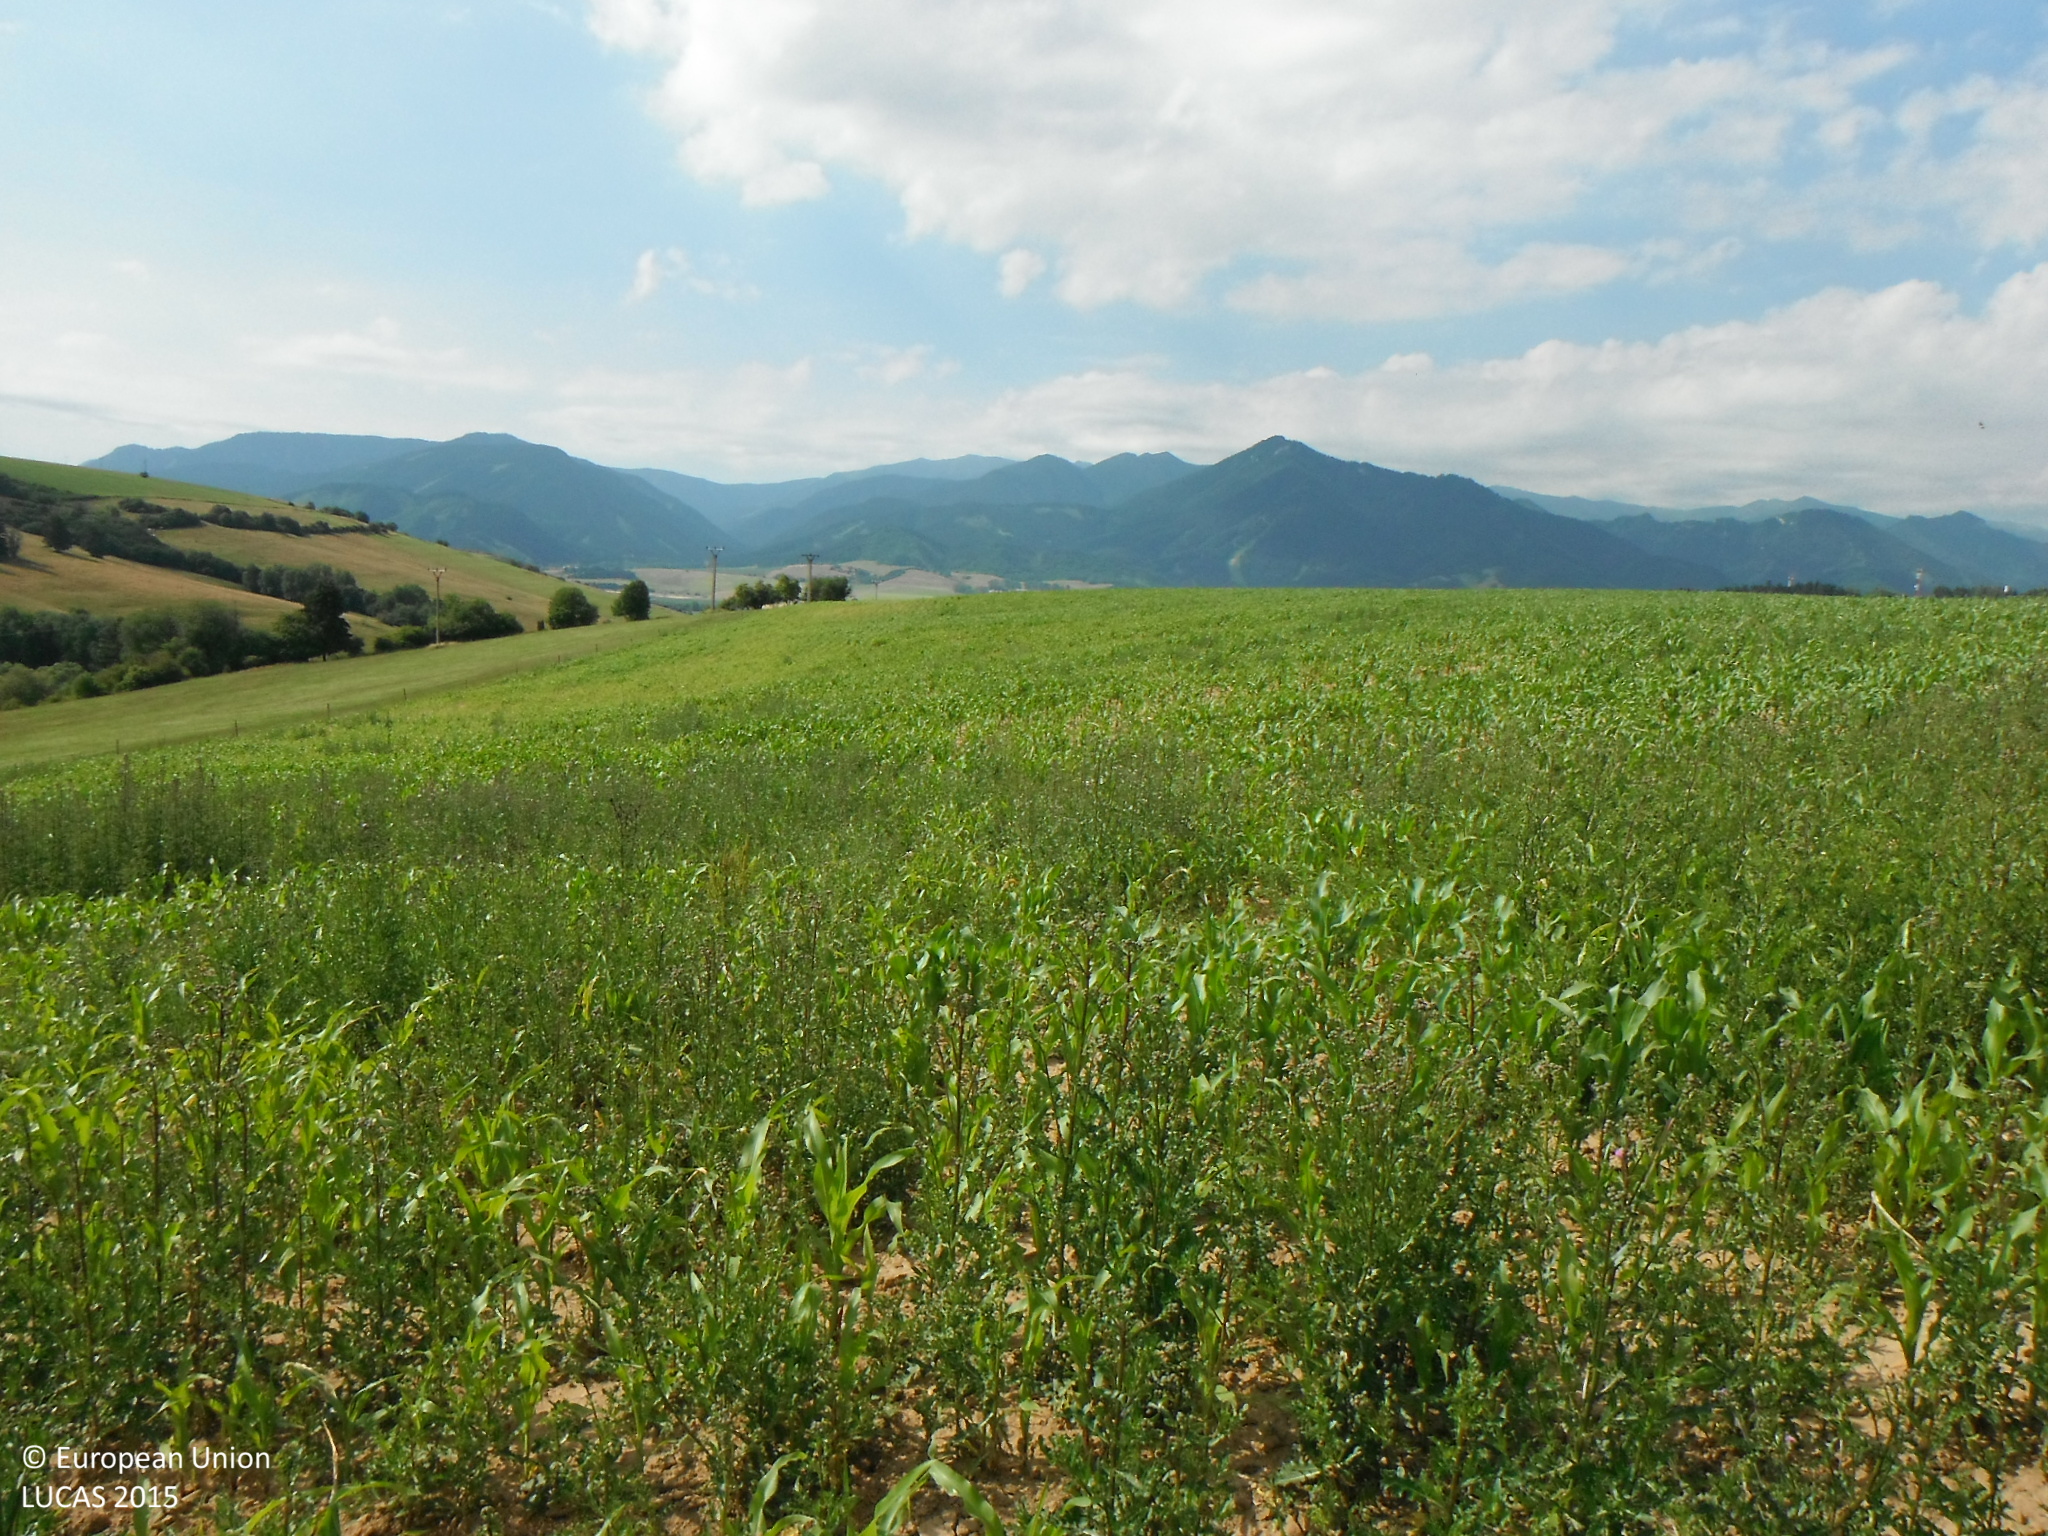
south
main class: Cropland
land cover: Maize
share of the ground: 50 - 75 %
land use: Agriculture (excluding fallow land and kitchen gardens)
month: July
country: SK
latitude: 49.1032
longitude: 19.6567
